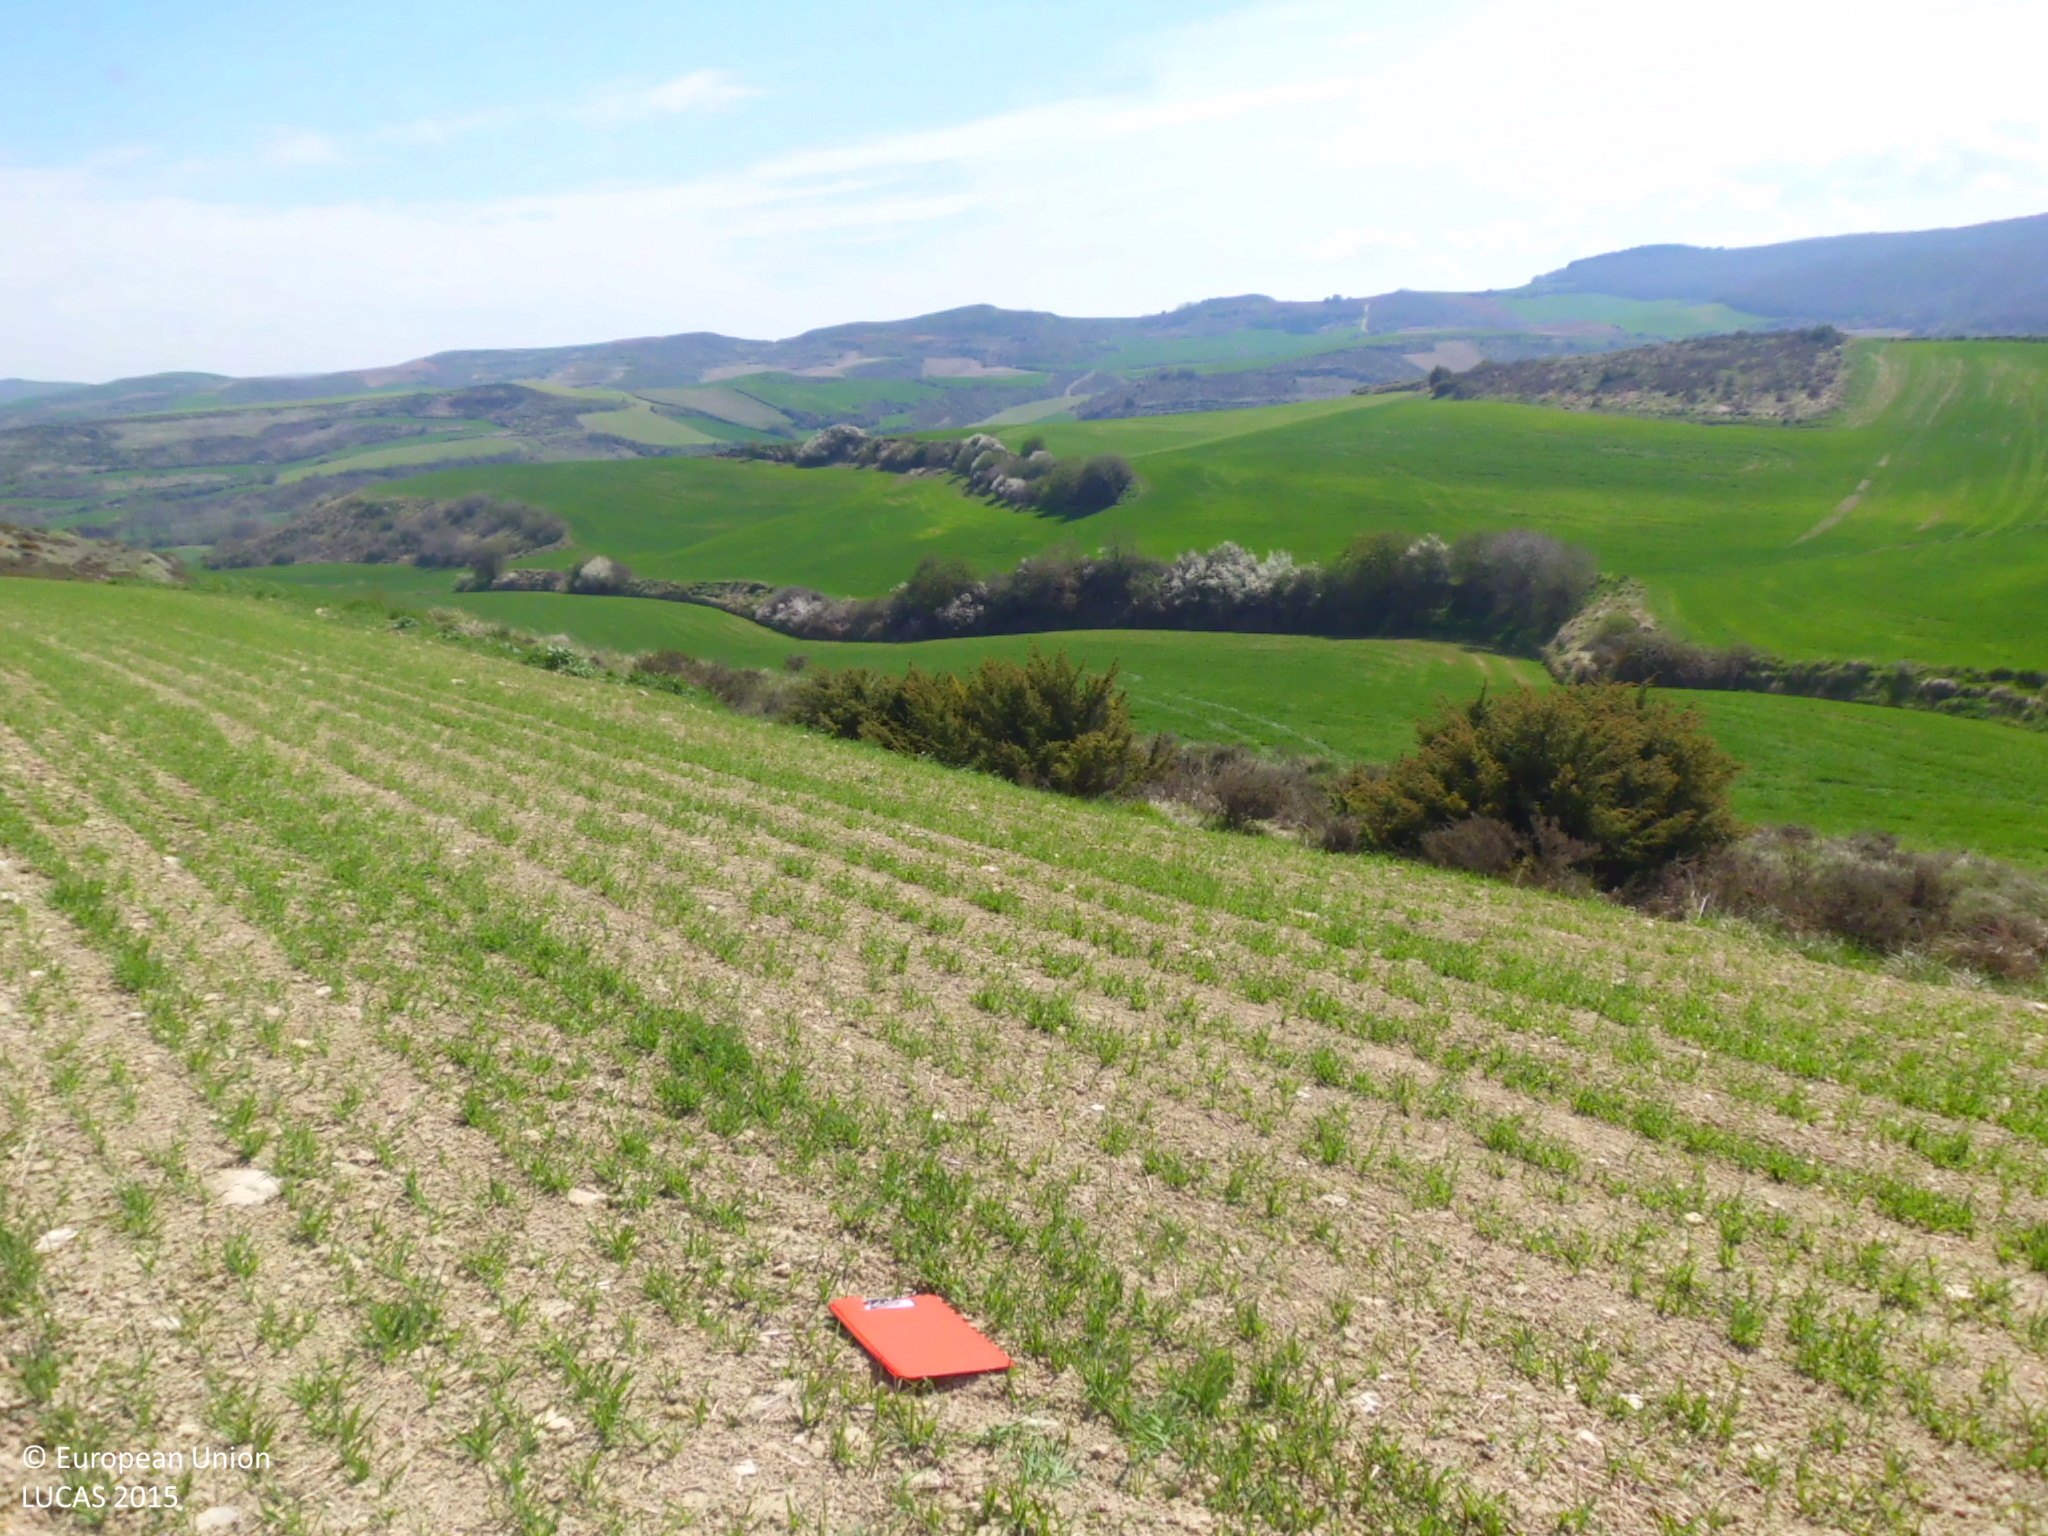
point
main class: Cropland
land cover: Barley
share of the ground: 10 - 25 %
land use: Agriculture (excluding fallow land and kitchen gardens)
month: April
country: ES
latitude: 42.4220
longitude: -3.3644
